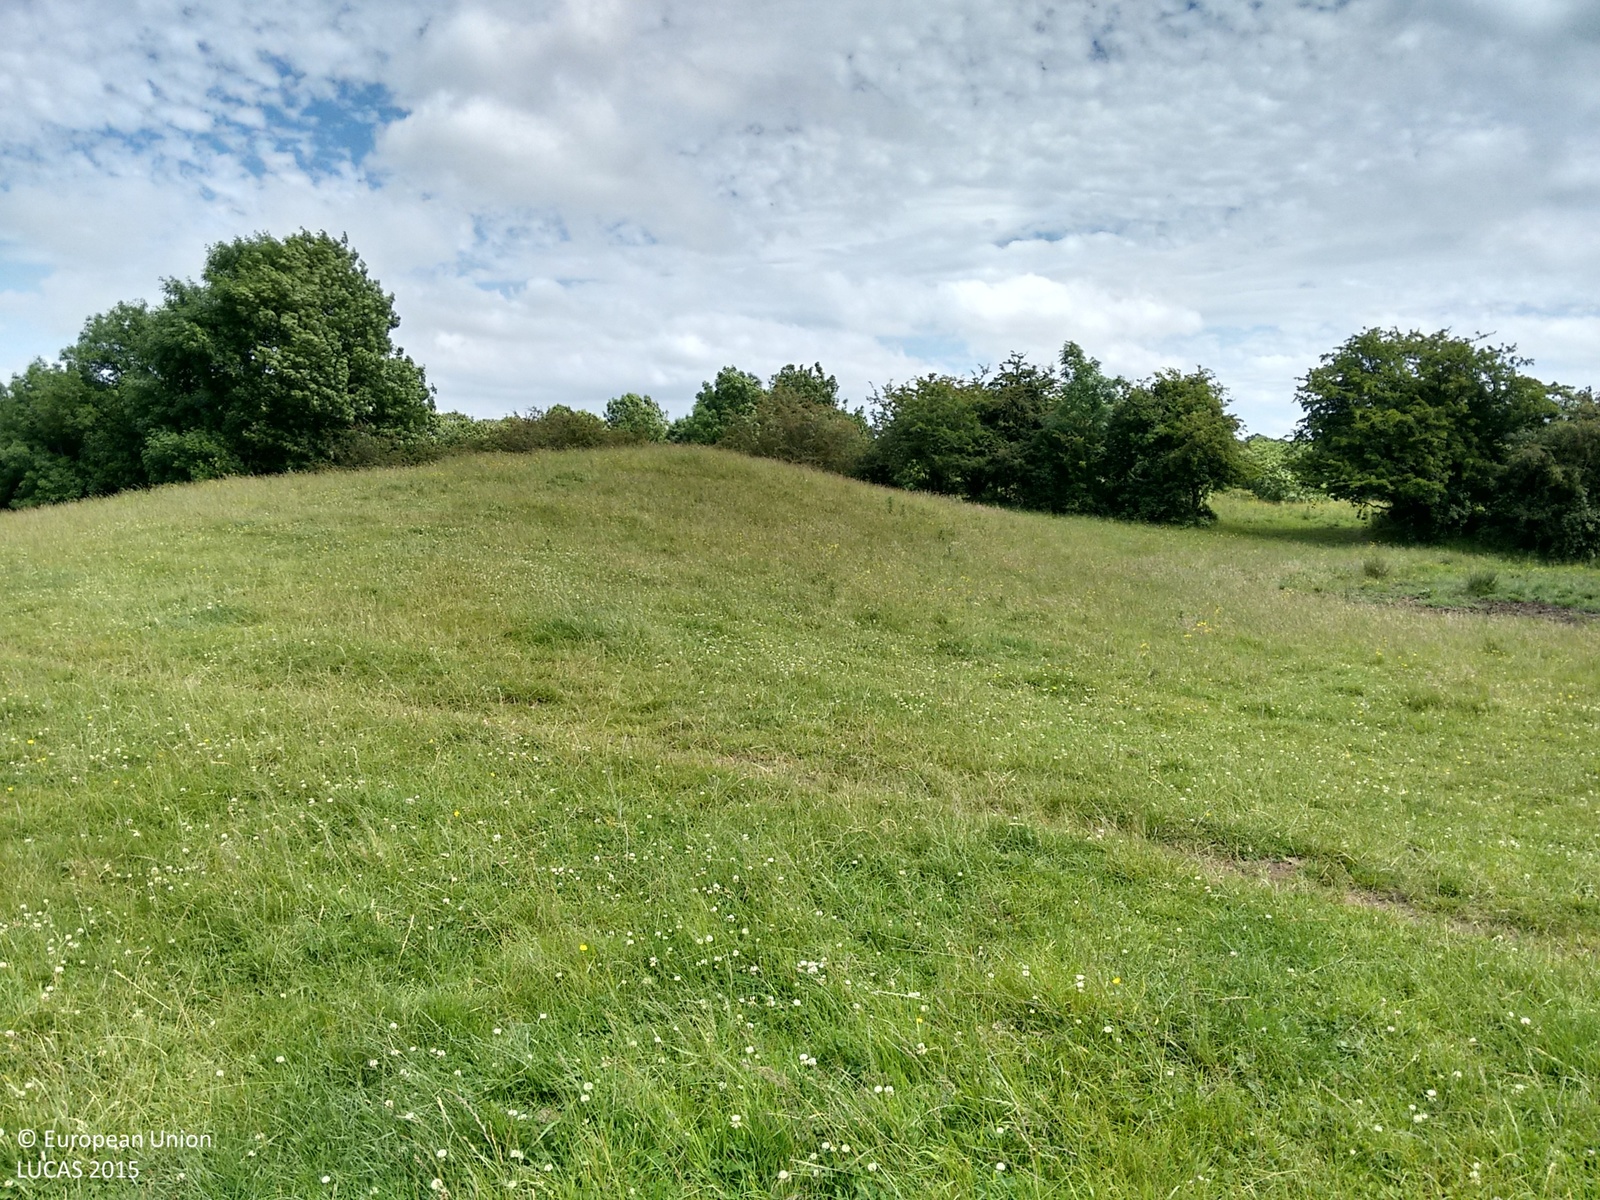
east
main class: Grassland
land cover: Grassland without tree/shrub cover
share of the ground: > 75 %
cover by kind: herbaceous plants 100 %
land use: Agriculture (excluding fallow land and kitchen gardens)
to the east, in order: Grassland without tree/shrub cover; Managed hedges; Grassland without tree/shrub cover; Managed hedges; Grassland without tree/shrub cover
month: June
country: IE
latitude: 53.6704
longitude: -7.0503
